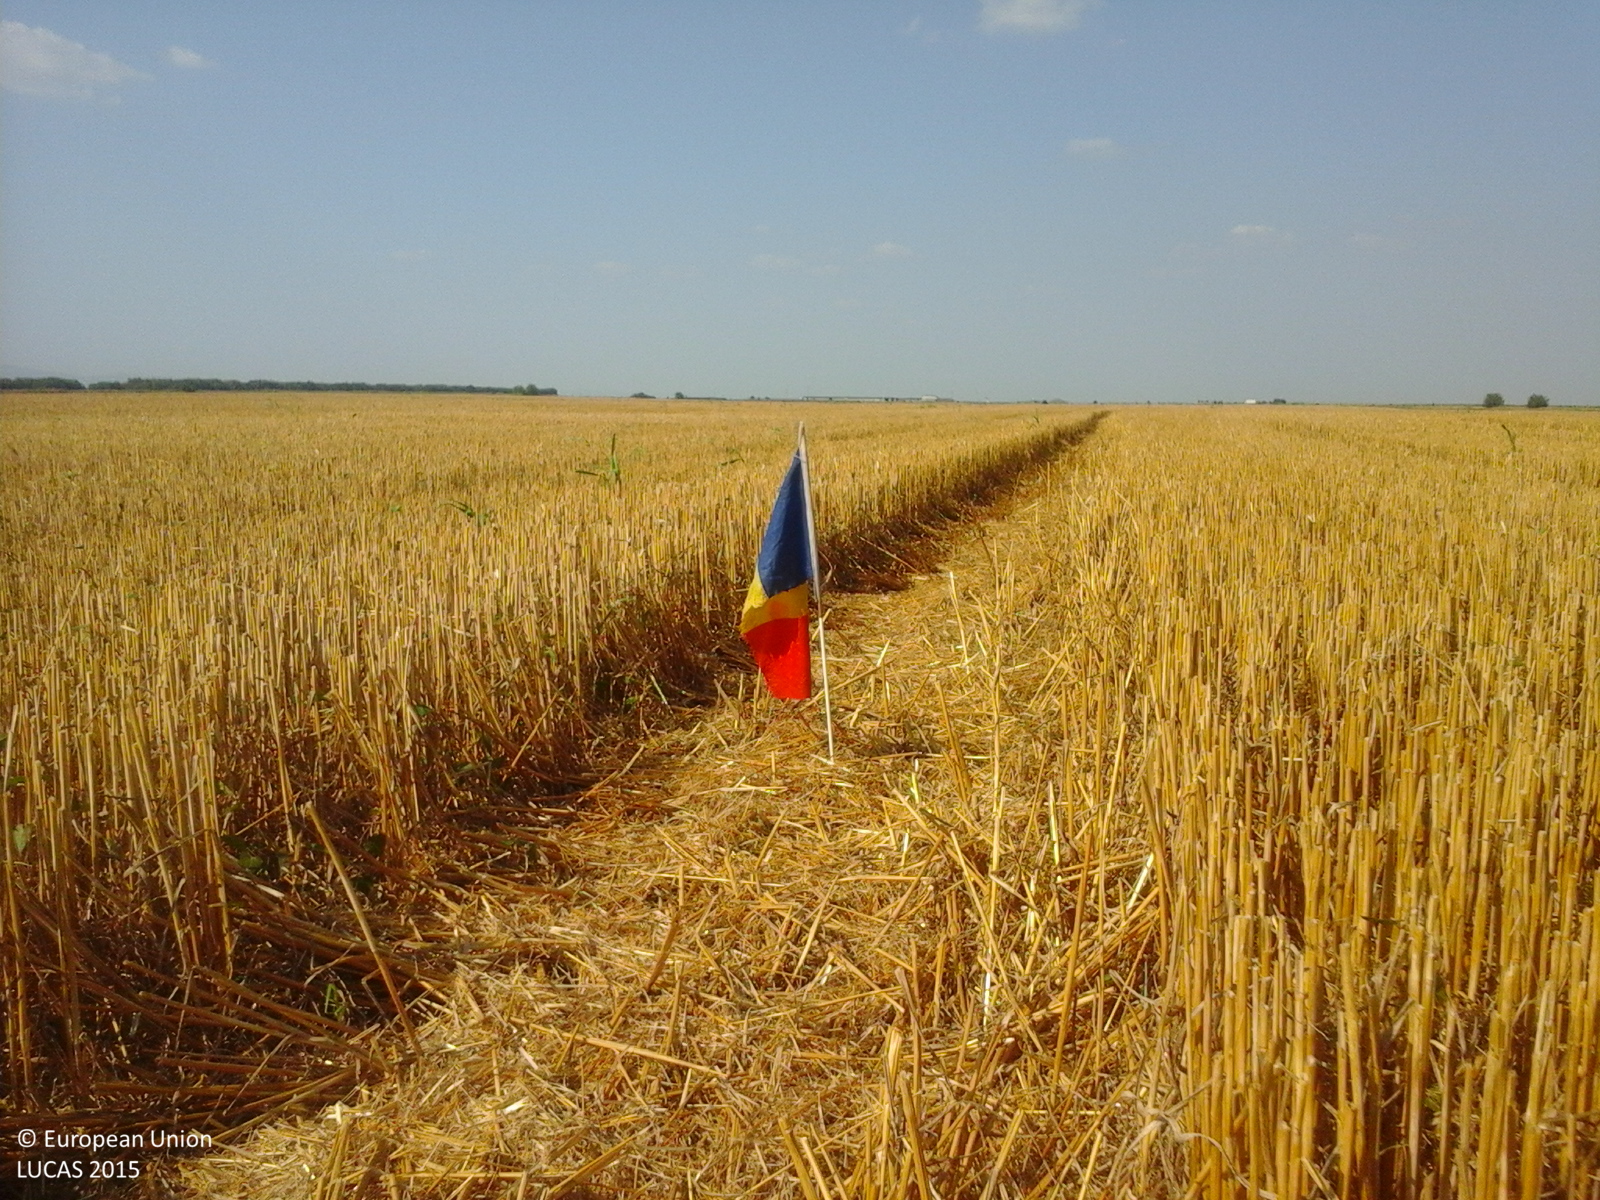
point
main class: Cropland
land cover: Durum wheat
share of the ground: > 75 %
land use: Agriculture (excluding fallow land and kitchen gardens)
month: July
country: RO
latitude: 44.8920
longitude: 26.6216
